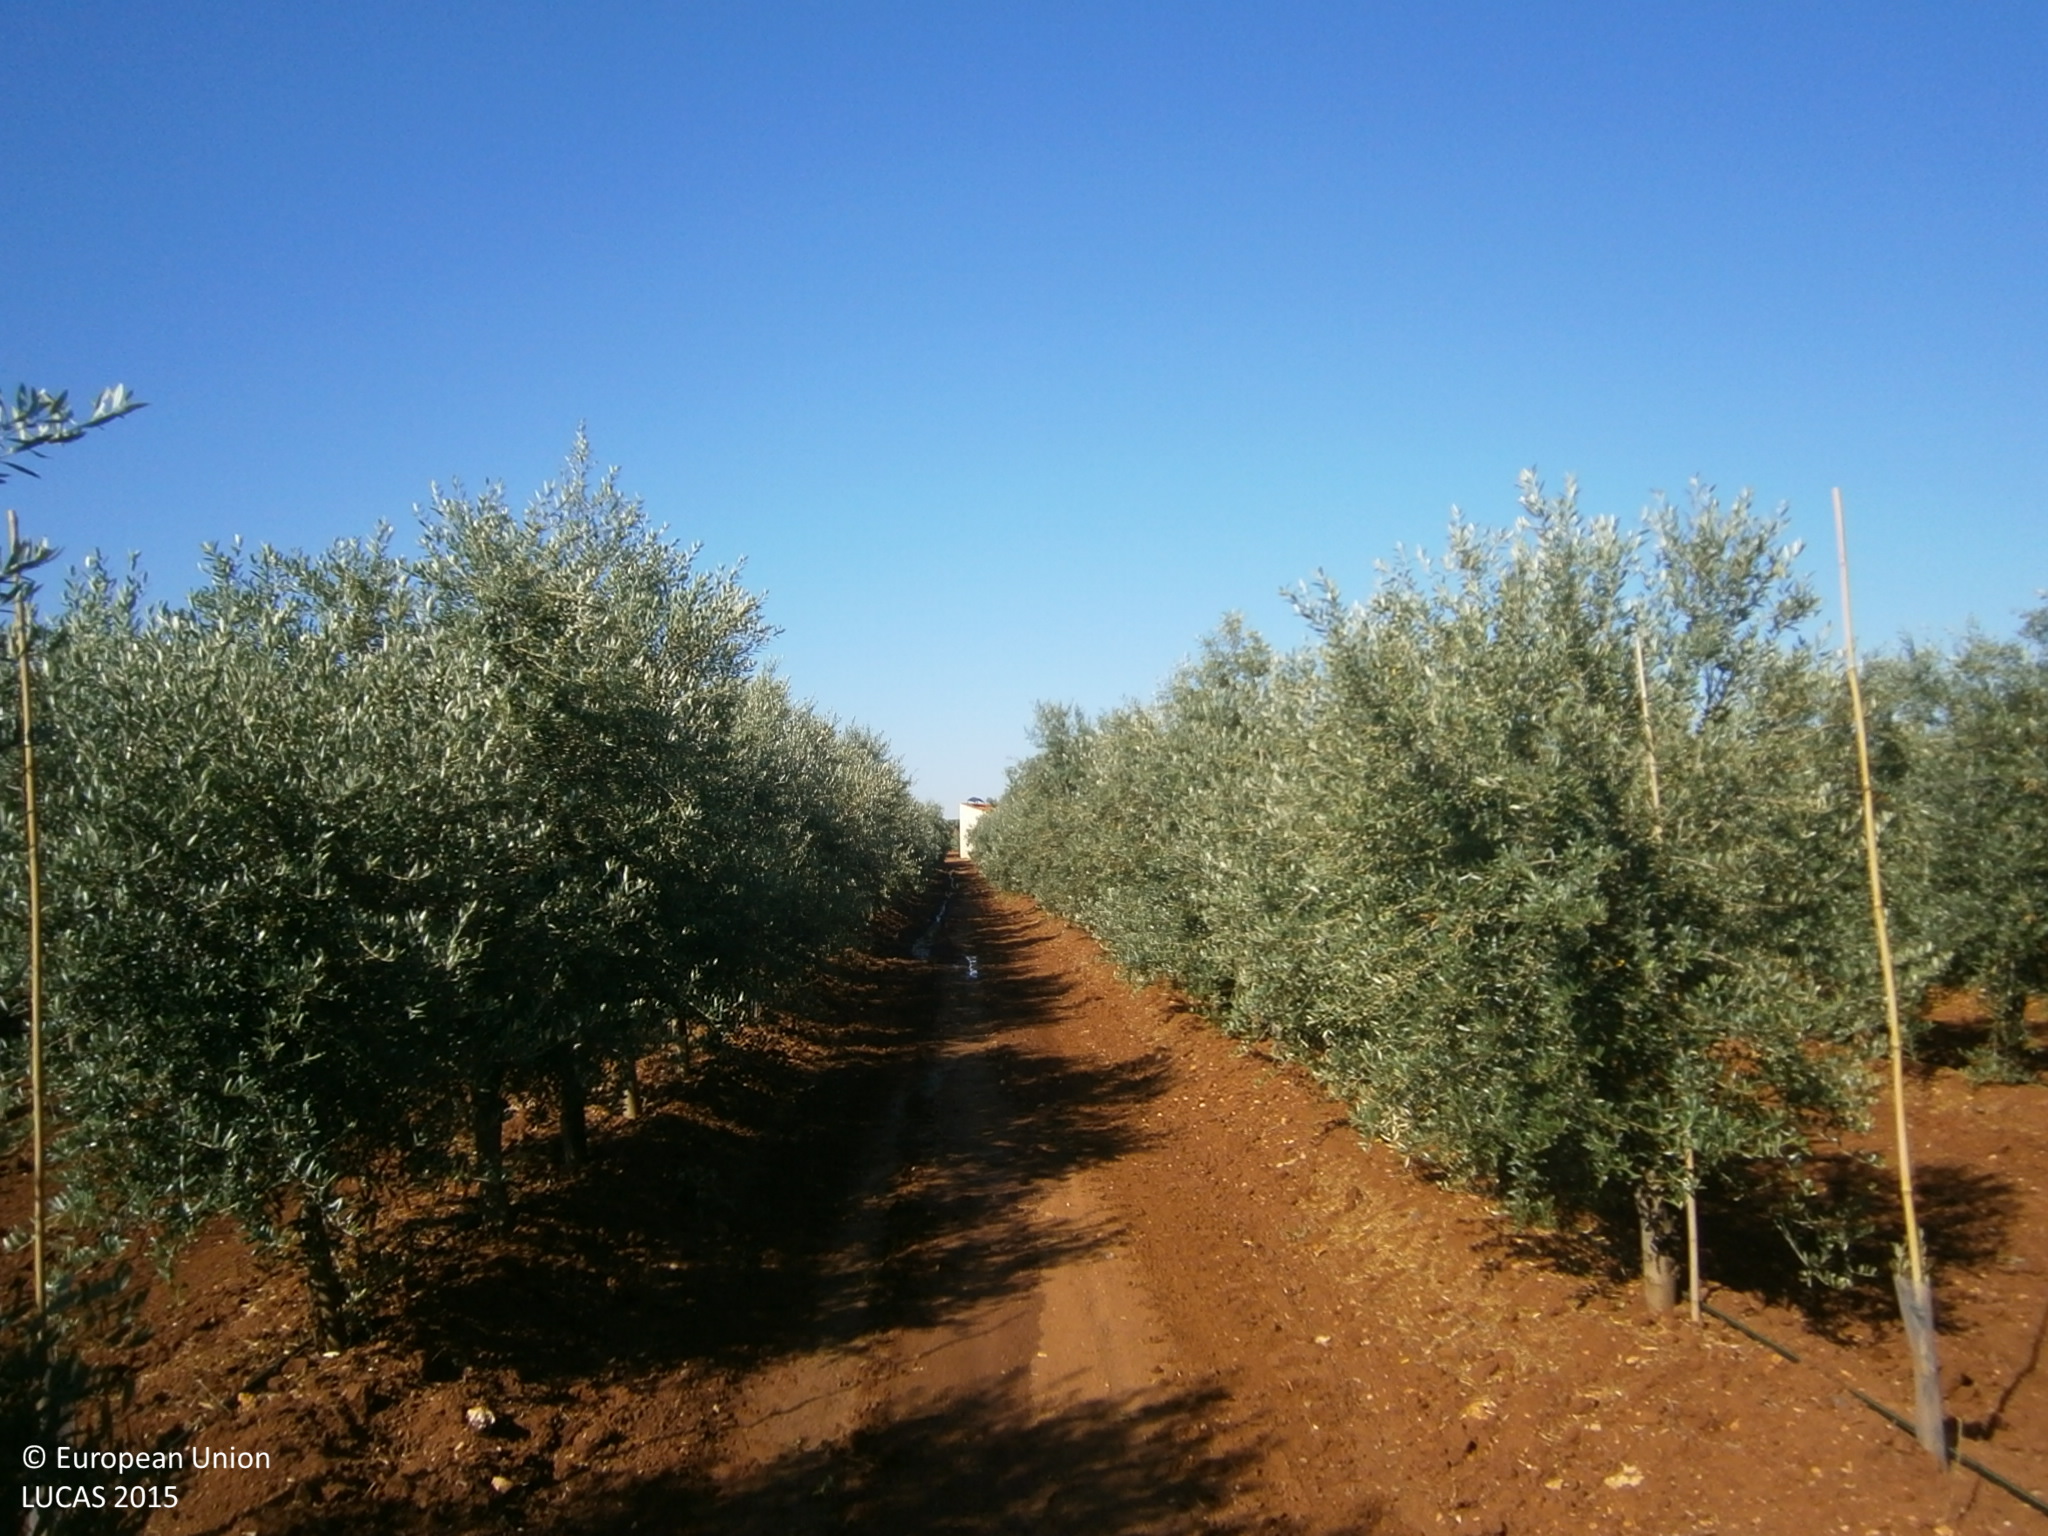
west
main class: Cropland
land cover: Olive groves
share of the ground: 25 - 50 %
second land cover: Other bare soil
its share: > 75 %
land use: Agriculture (excluding fallow land and kitchen gardens)
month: June
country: ES
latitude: 38.6861
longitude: -6.6484
